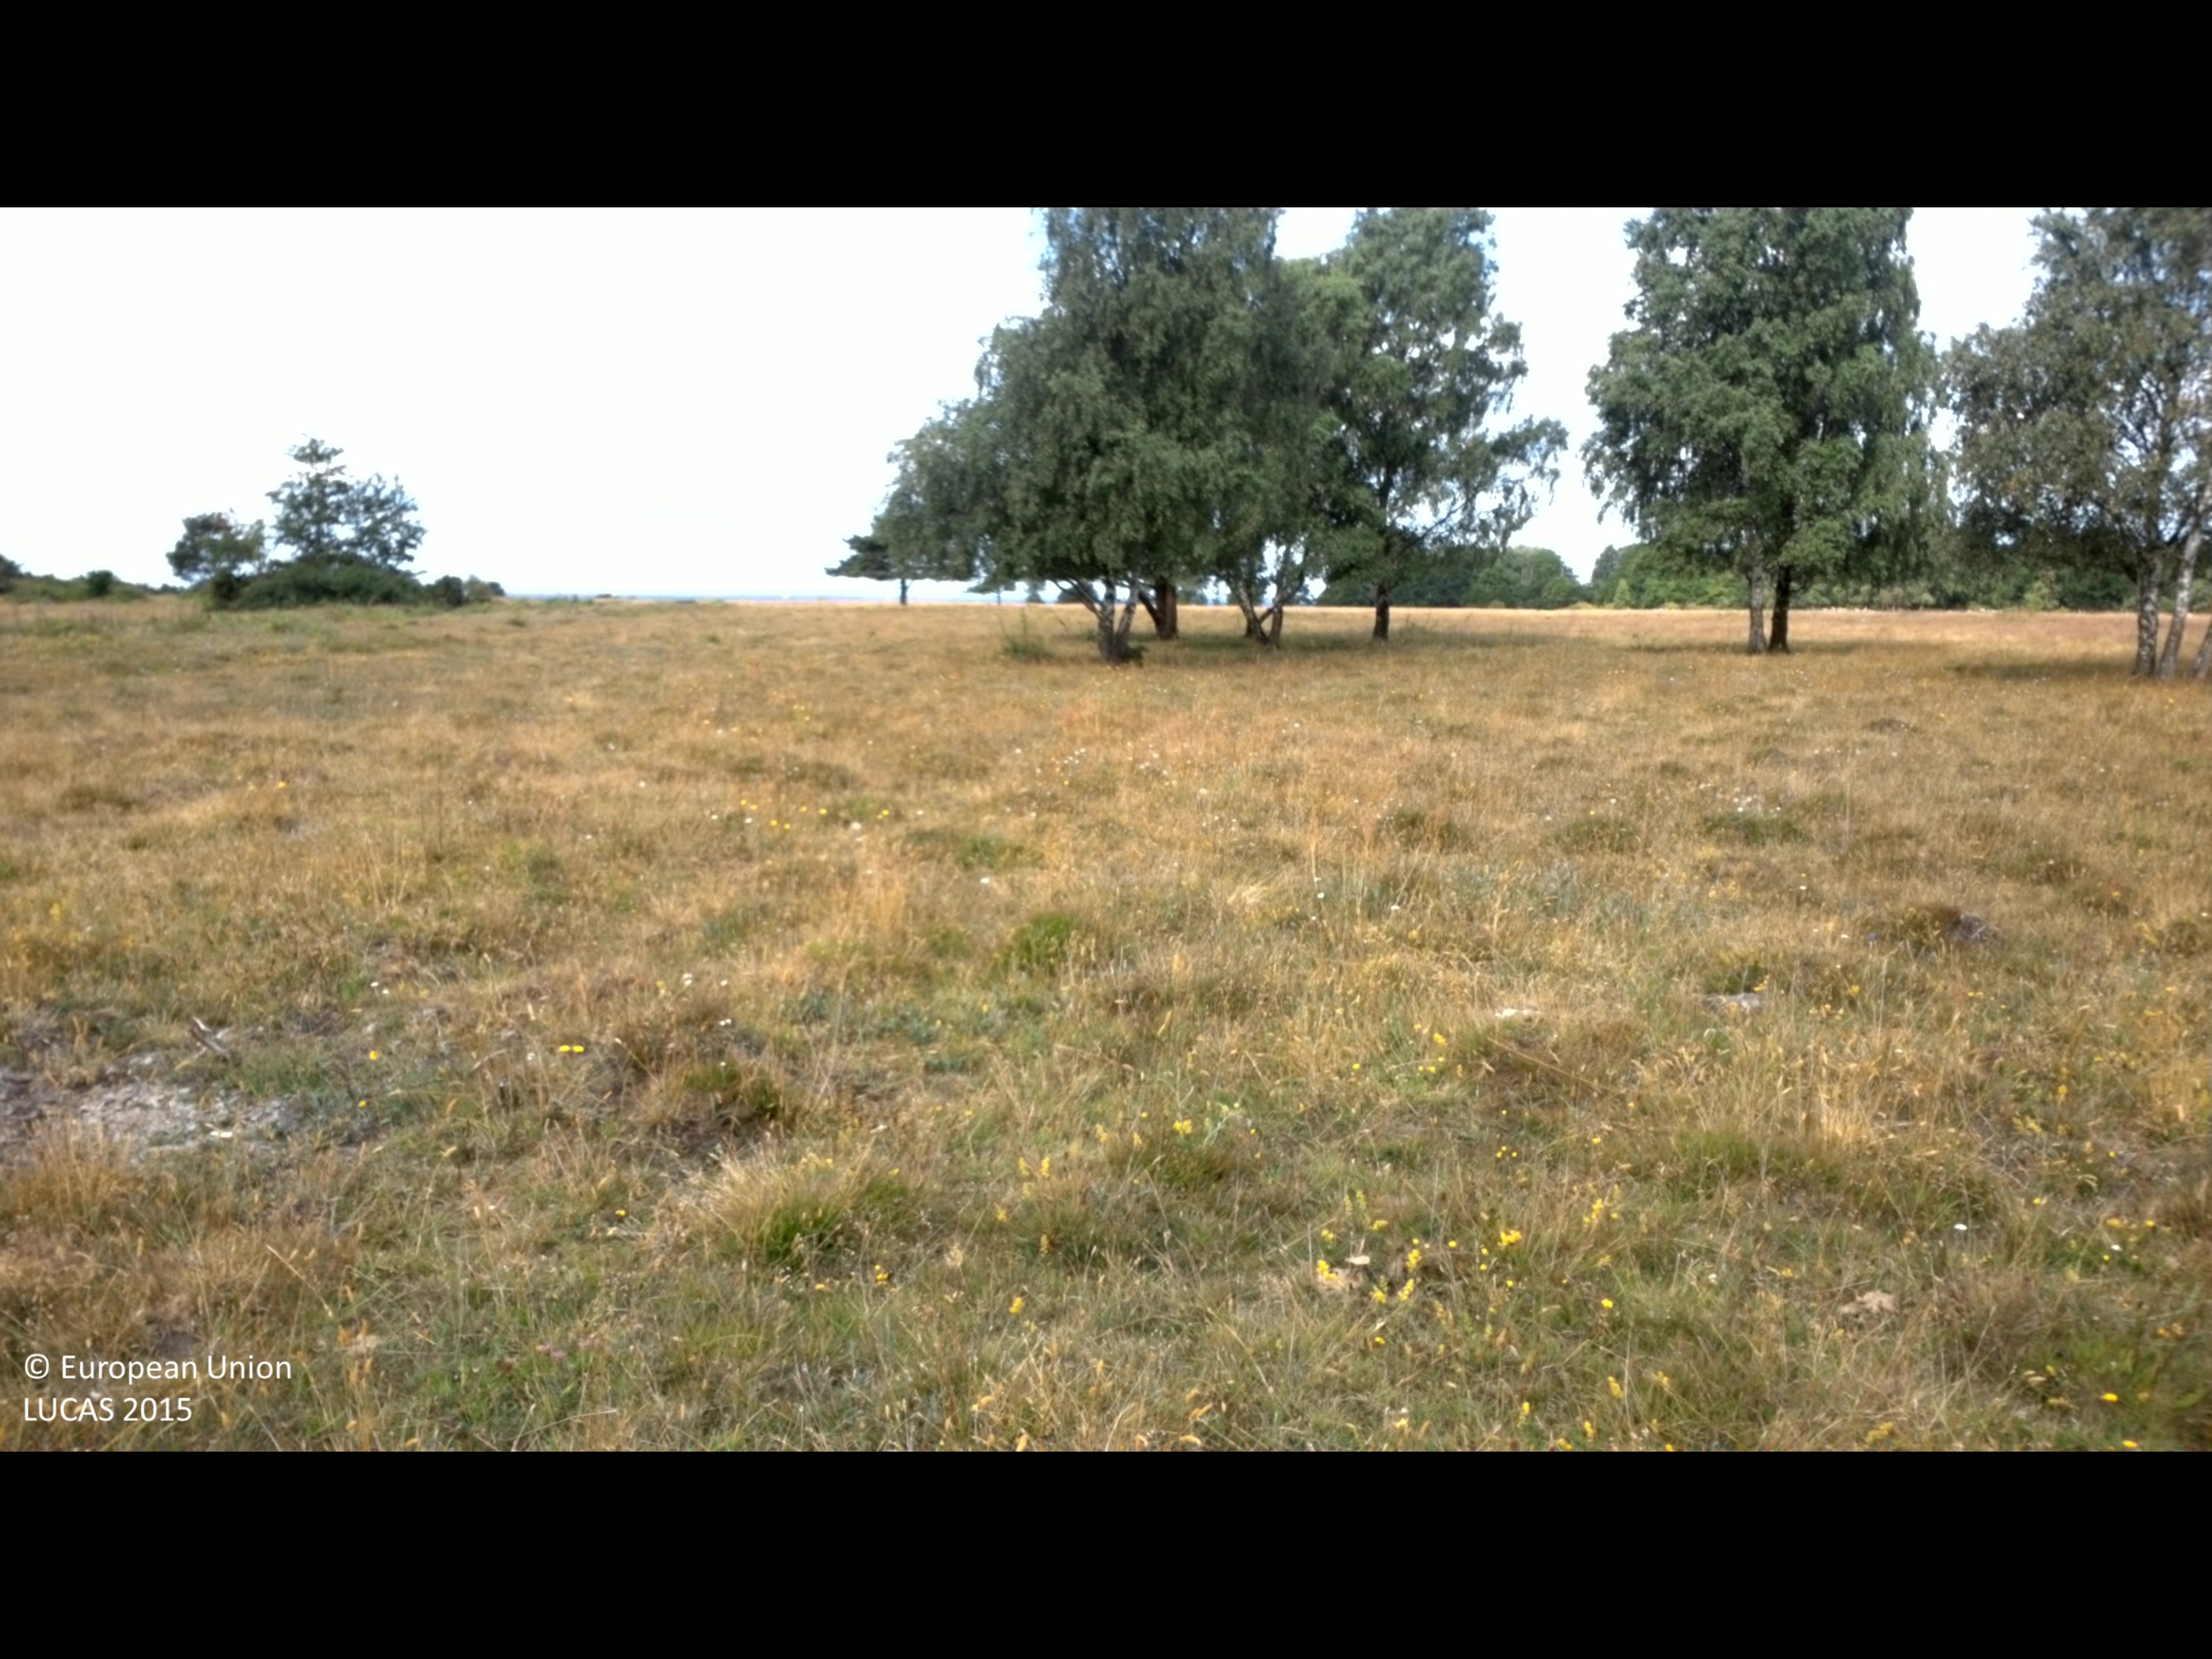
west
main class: Grassland
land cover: Grassland without tree/shrub cover
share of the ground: > 75 %
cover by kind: herbaceous plants 95 %, shrubs 5 %
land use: Agriculture (excluding fallow land and kitchen gardens)
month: July
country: SE
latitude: 56.4800
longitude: 16.3825
